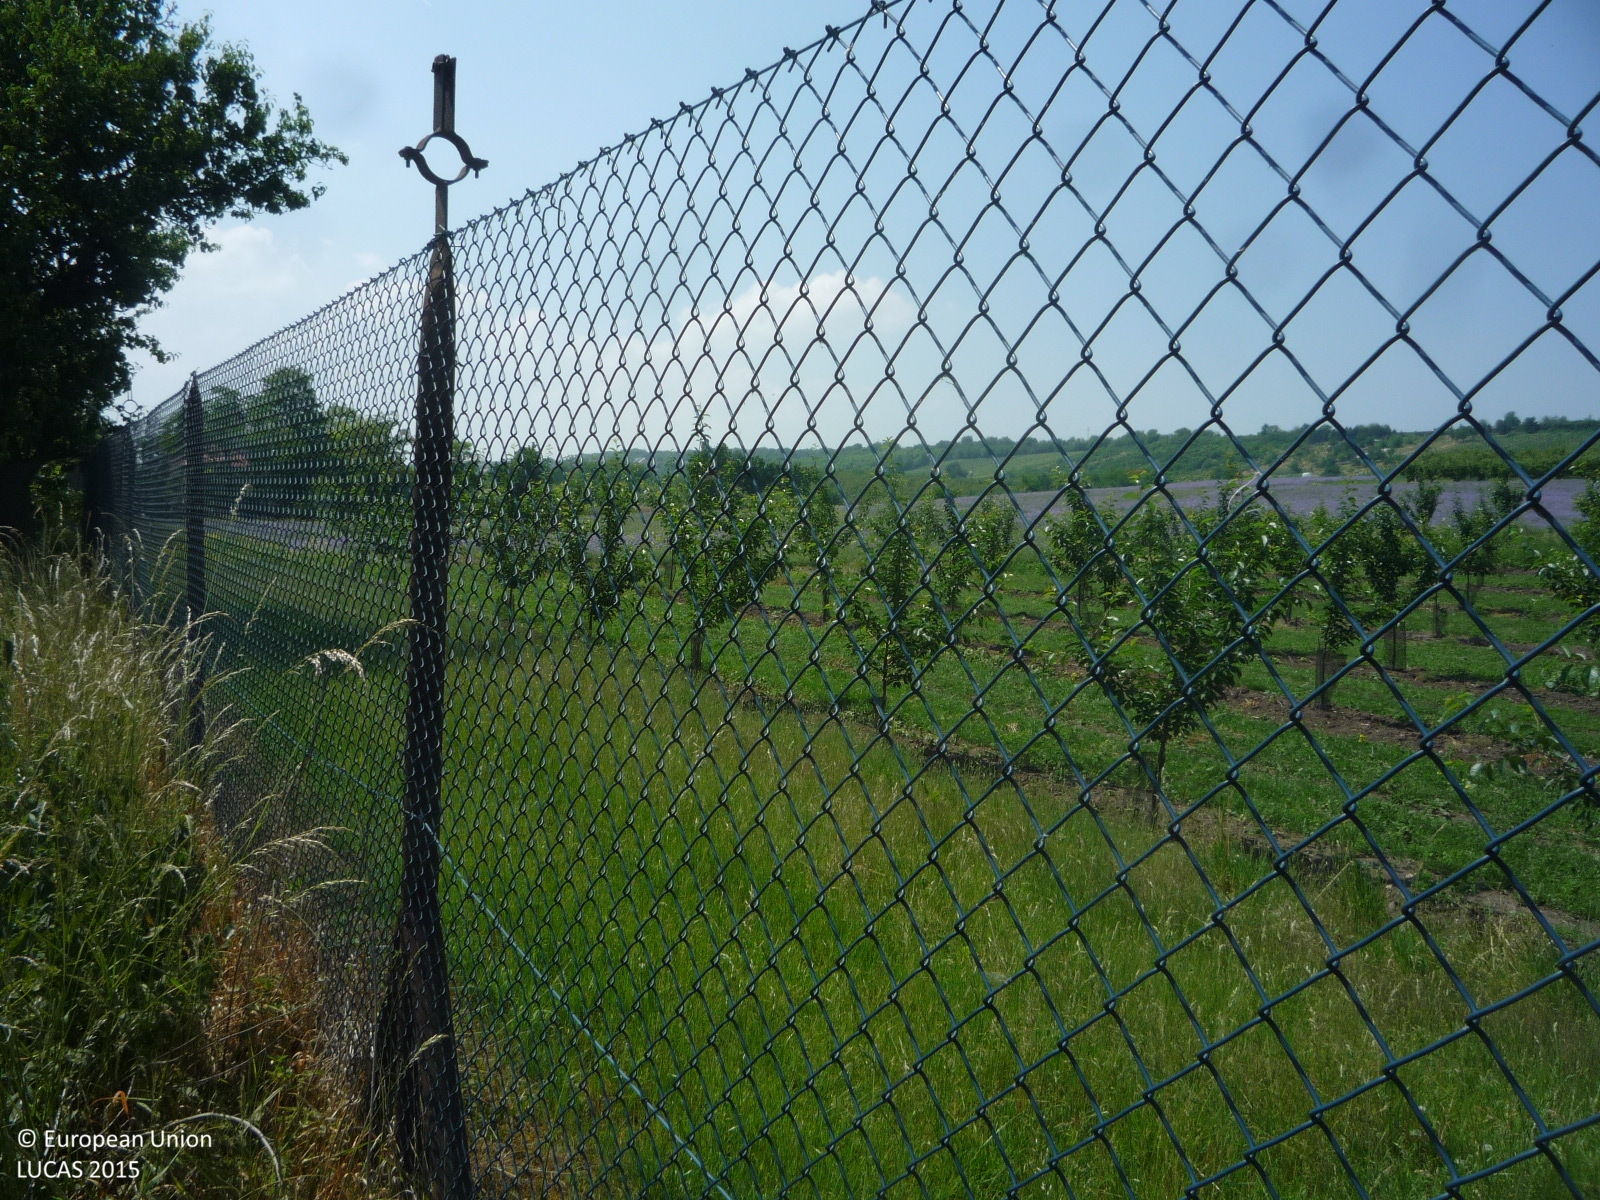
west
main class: Cropland
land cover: Cherry fruit
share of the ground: 25 - 50 %
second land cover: Grassland without tree/shrub cover
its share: > 75 %
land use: Agriculture (excluding fallow land and kitchen gardens)
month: June
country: CZ
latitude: 50.2363
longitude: 14.1090
